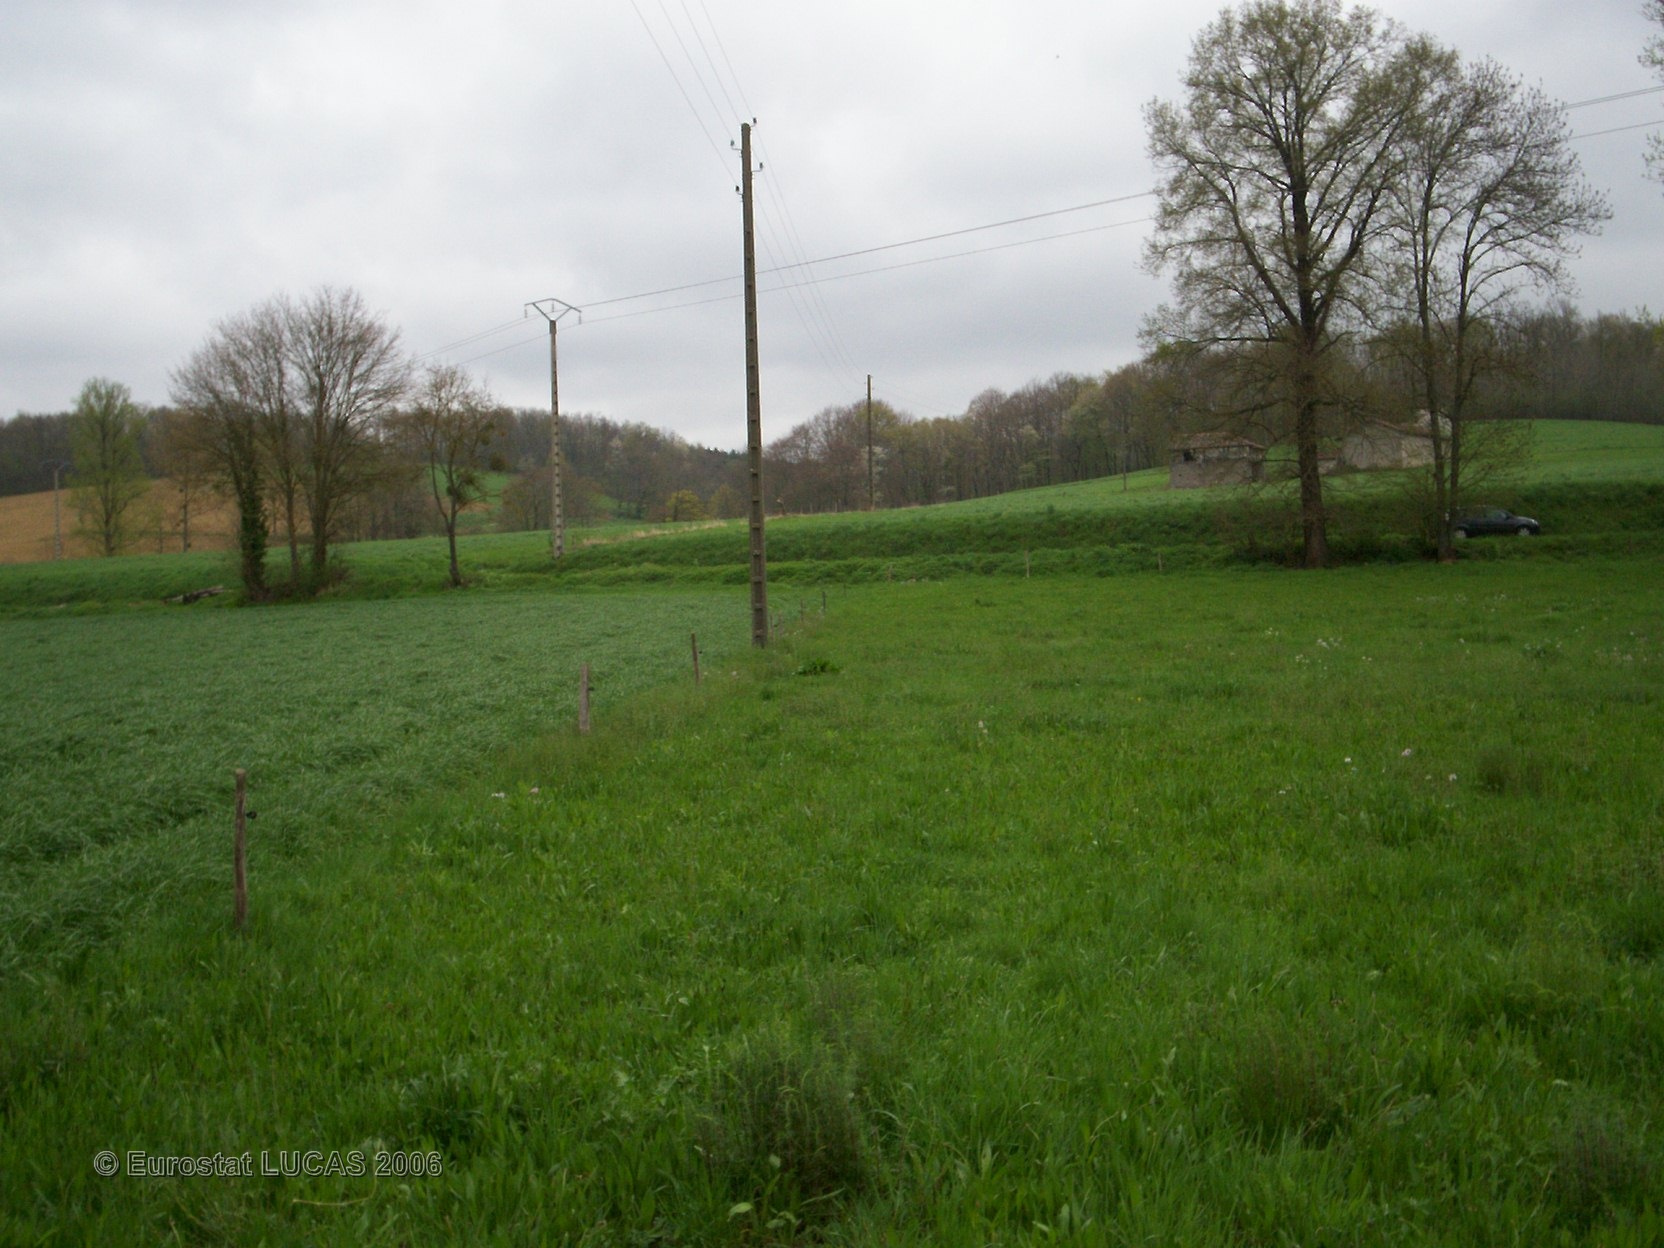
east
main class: Grassland
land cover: Grassland without tree/shrub cover
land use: Agriculture (excluding fallow land and kitchen gardens)
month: April
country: FR
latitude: 43.0455
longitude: 0.9316
